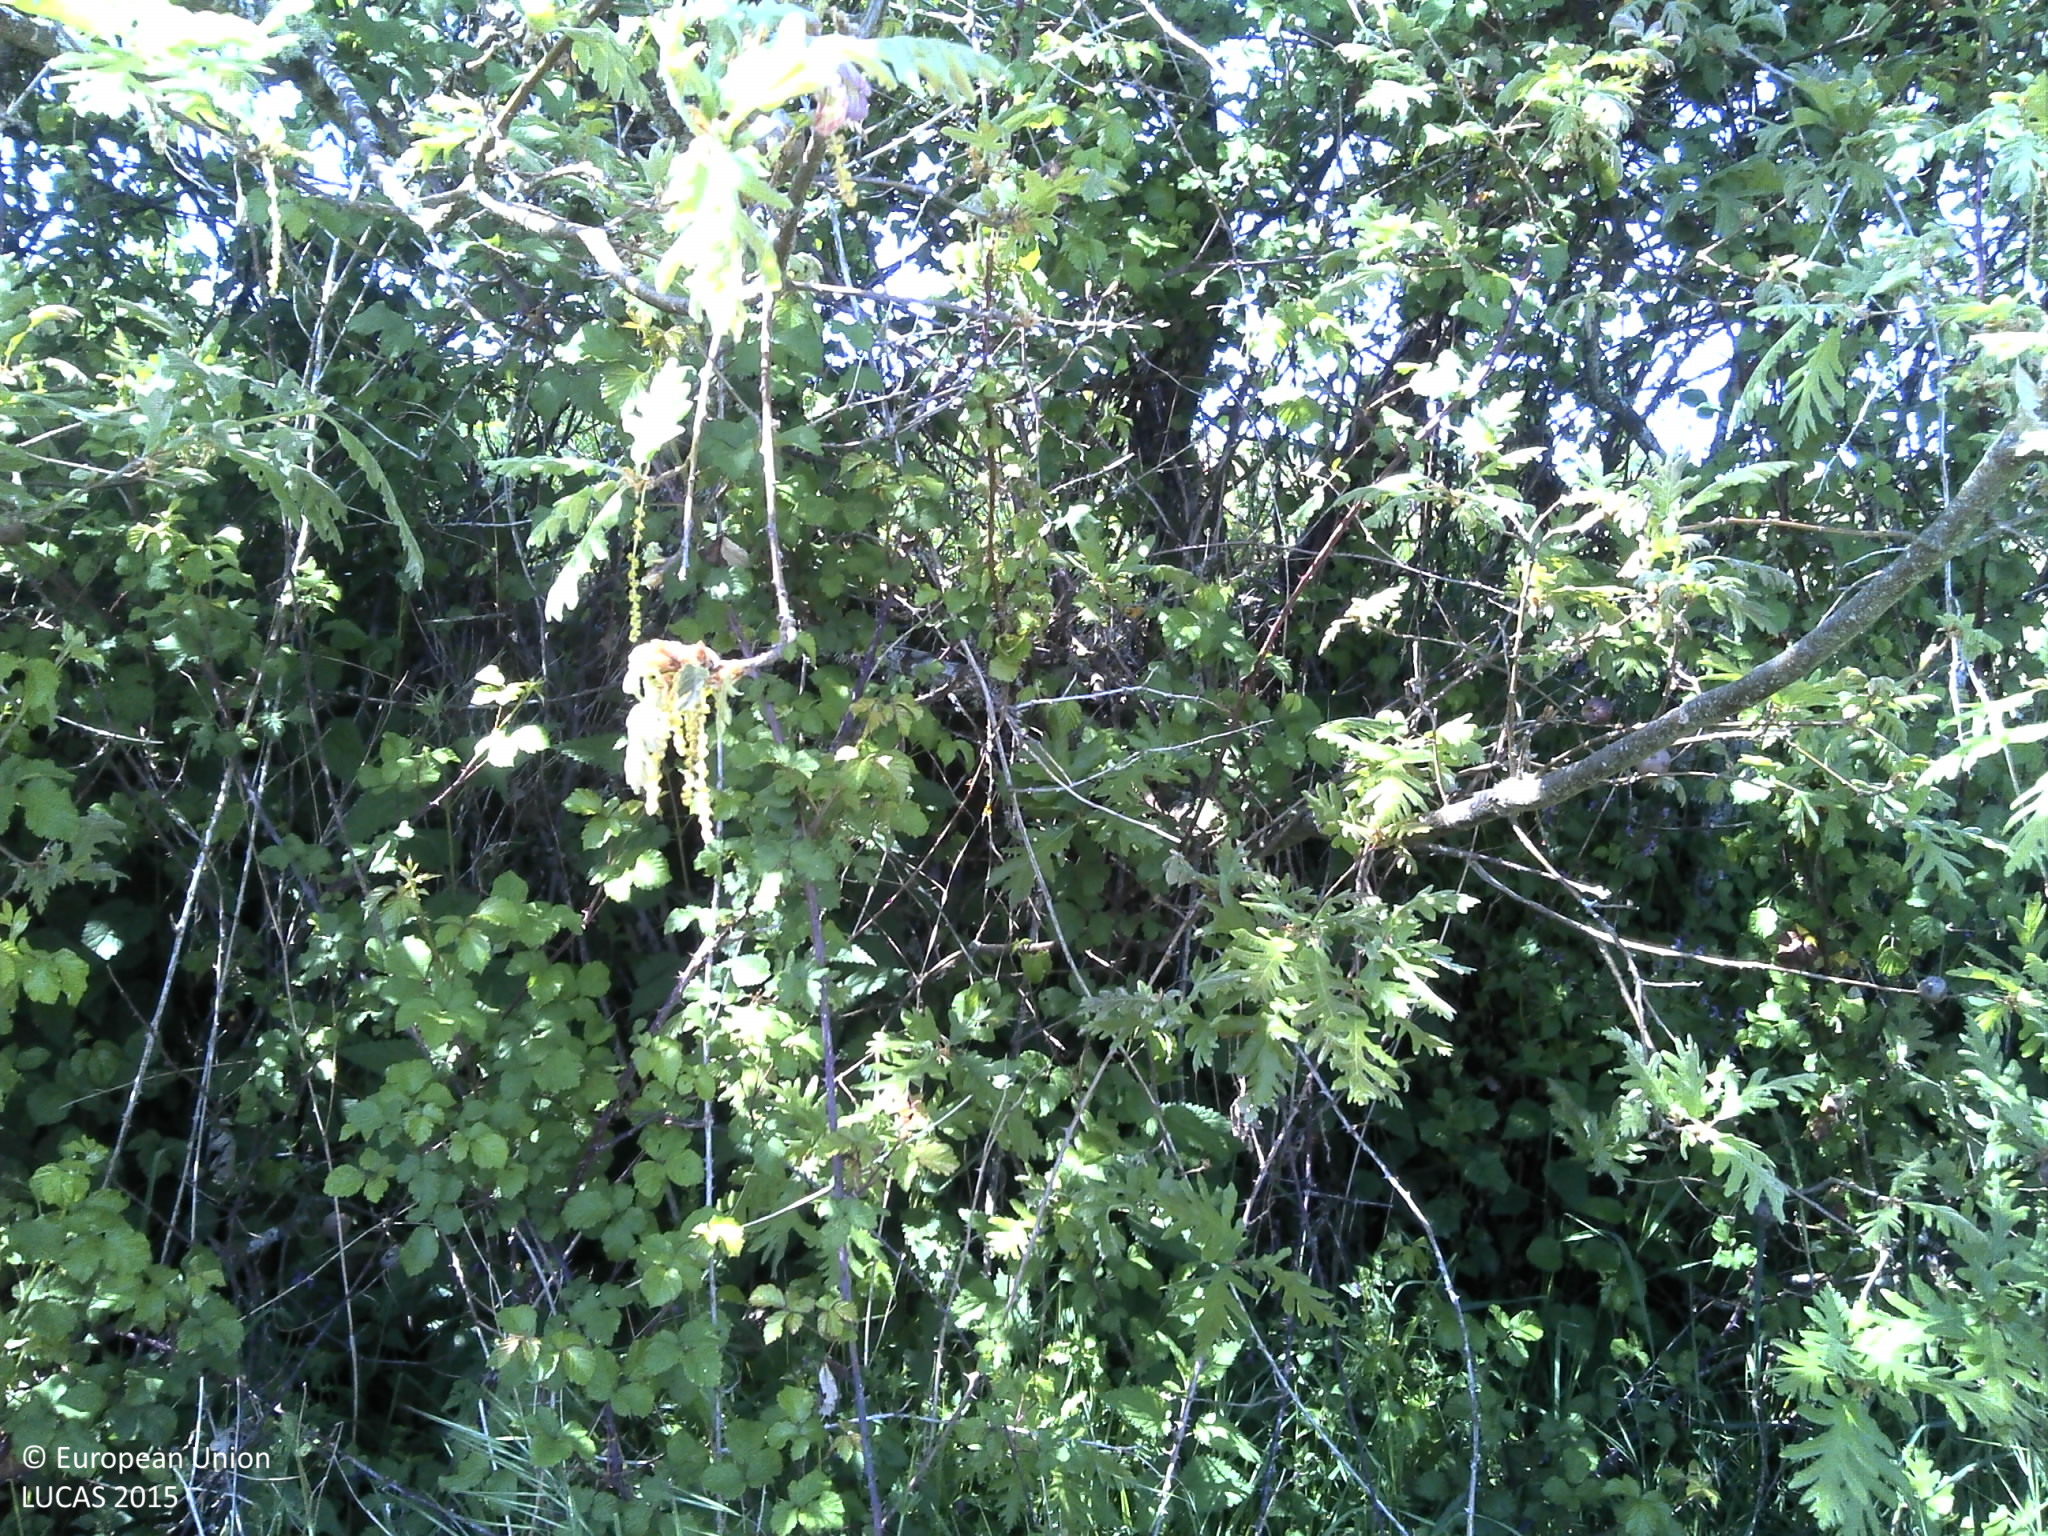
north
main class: Grassland
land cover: Grassland with sparse tree/shrub cover
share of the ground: > 75 %
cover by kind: herbaceous plants 80 %, shrubs 10 %, broadleaved forest trees 5 %, unconsolidated bare surface 5 %
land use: Agriculture (excluding fallow land and kitchen gardens)
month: May
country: PT
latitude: 41.0062
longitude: -7.9050
